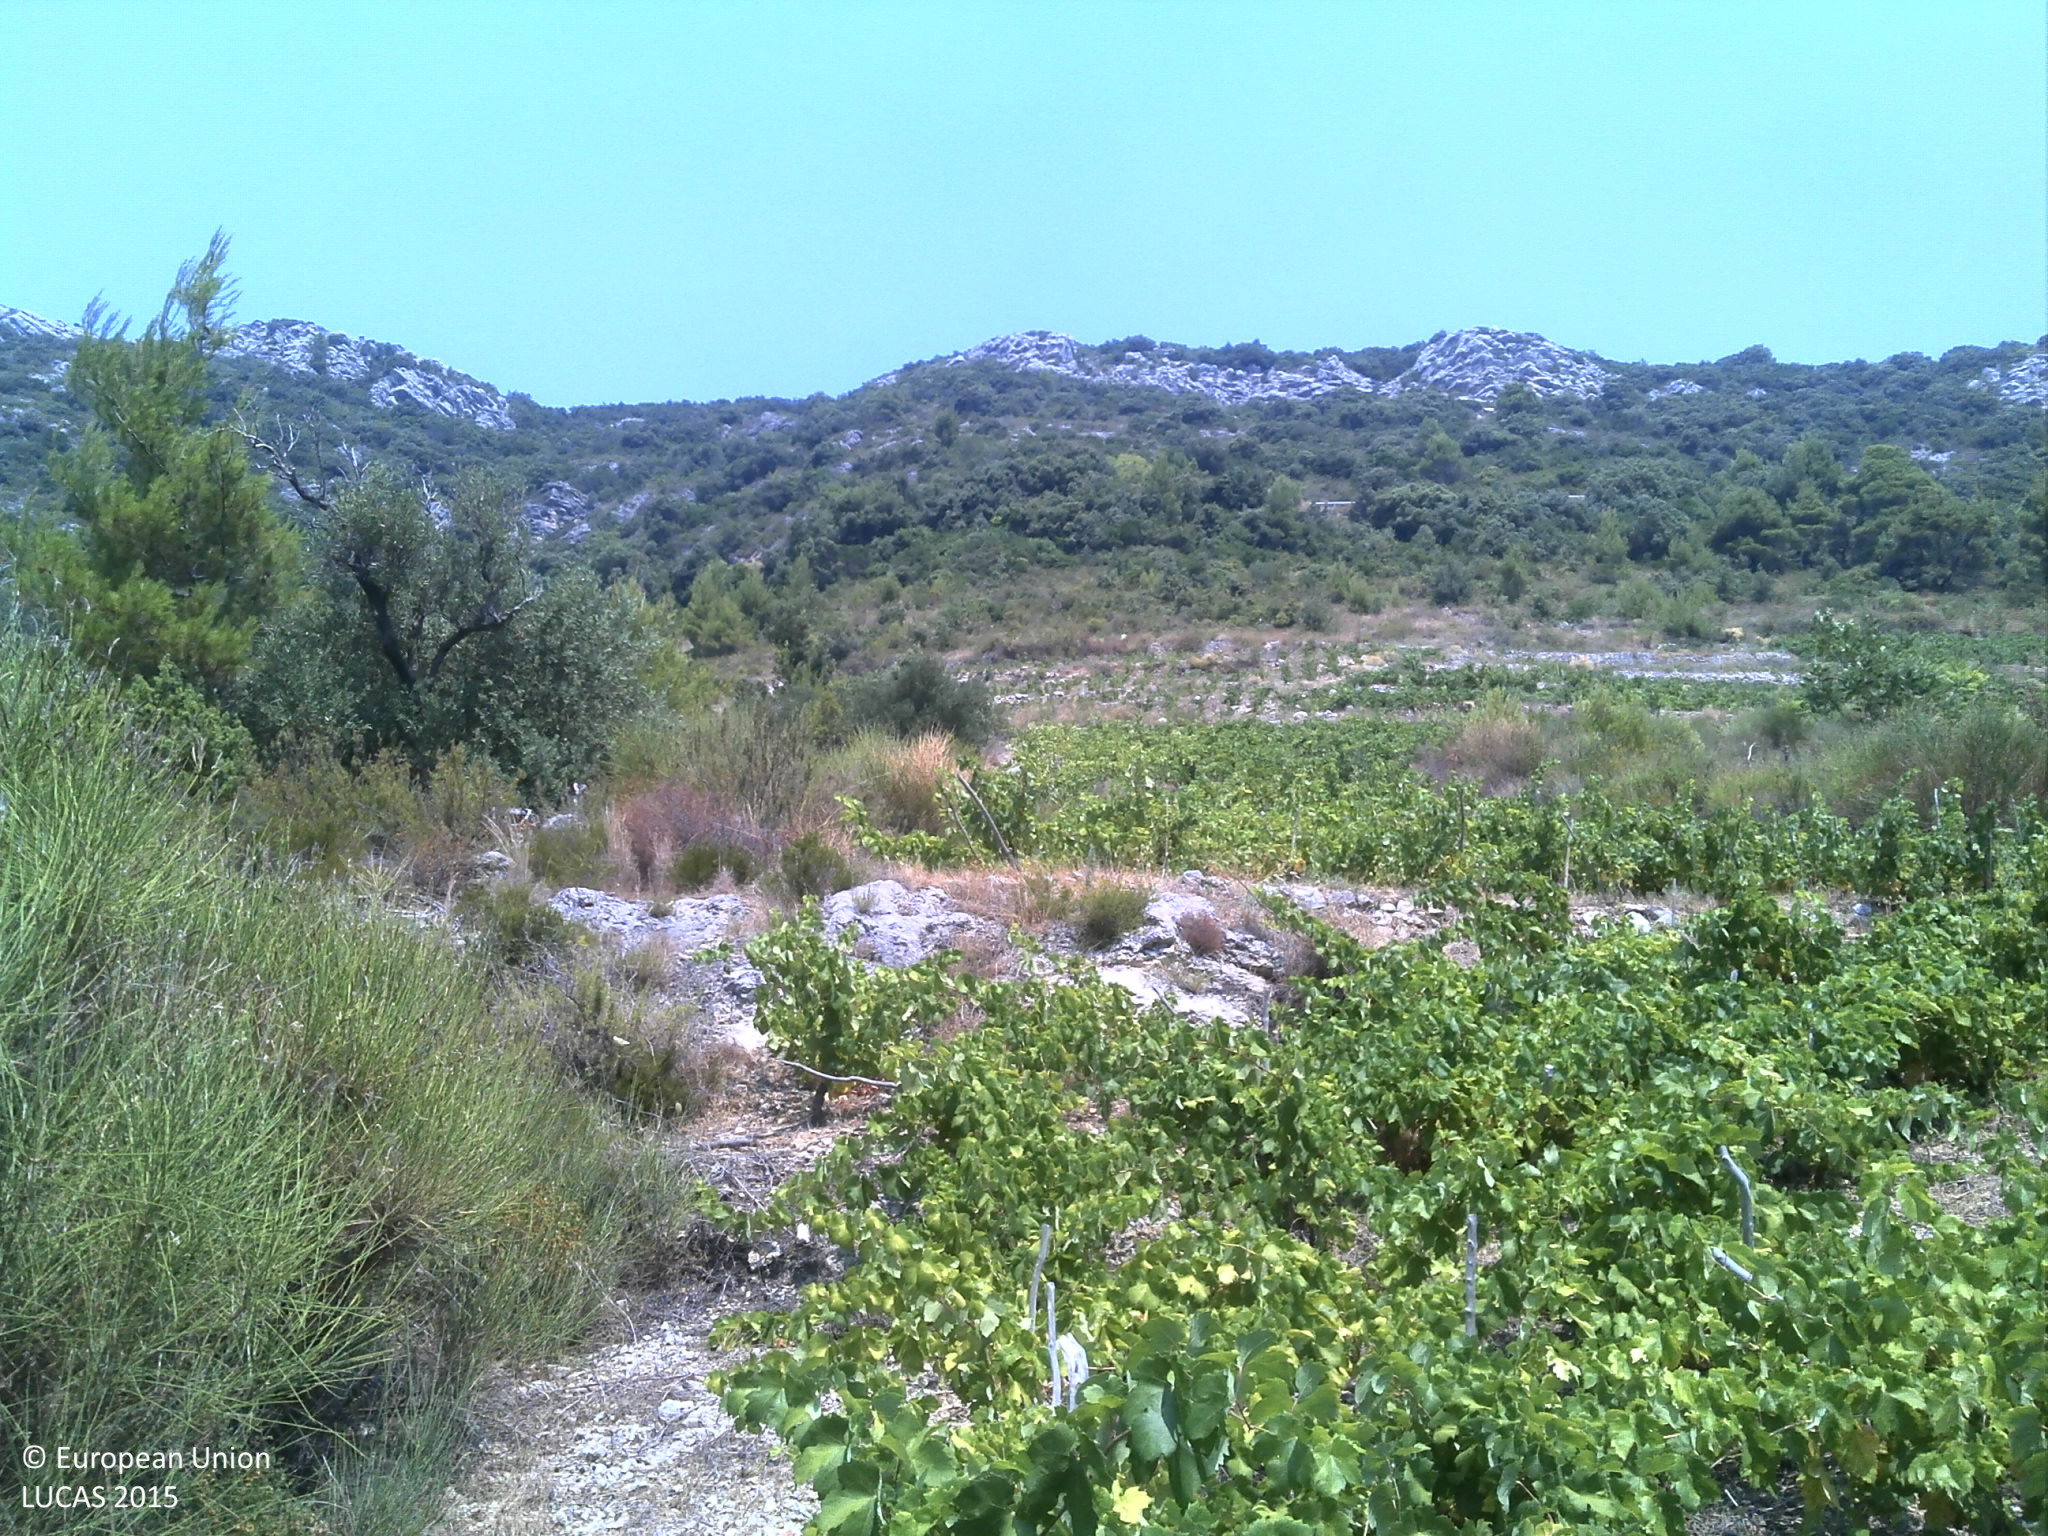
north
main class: Cropland
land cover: Vineyards
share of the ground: > 75 %
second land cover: Grassland without tree/shrub cover
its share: > 75 %
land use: Agriculture (excluding fallow land and kitchen gardens)
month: July
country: HR
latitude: 42.8854
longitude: 17.4709
